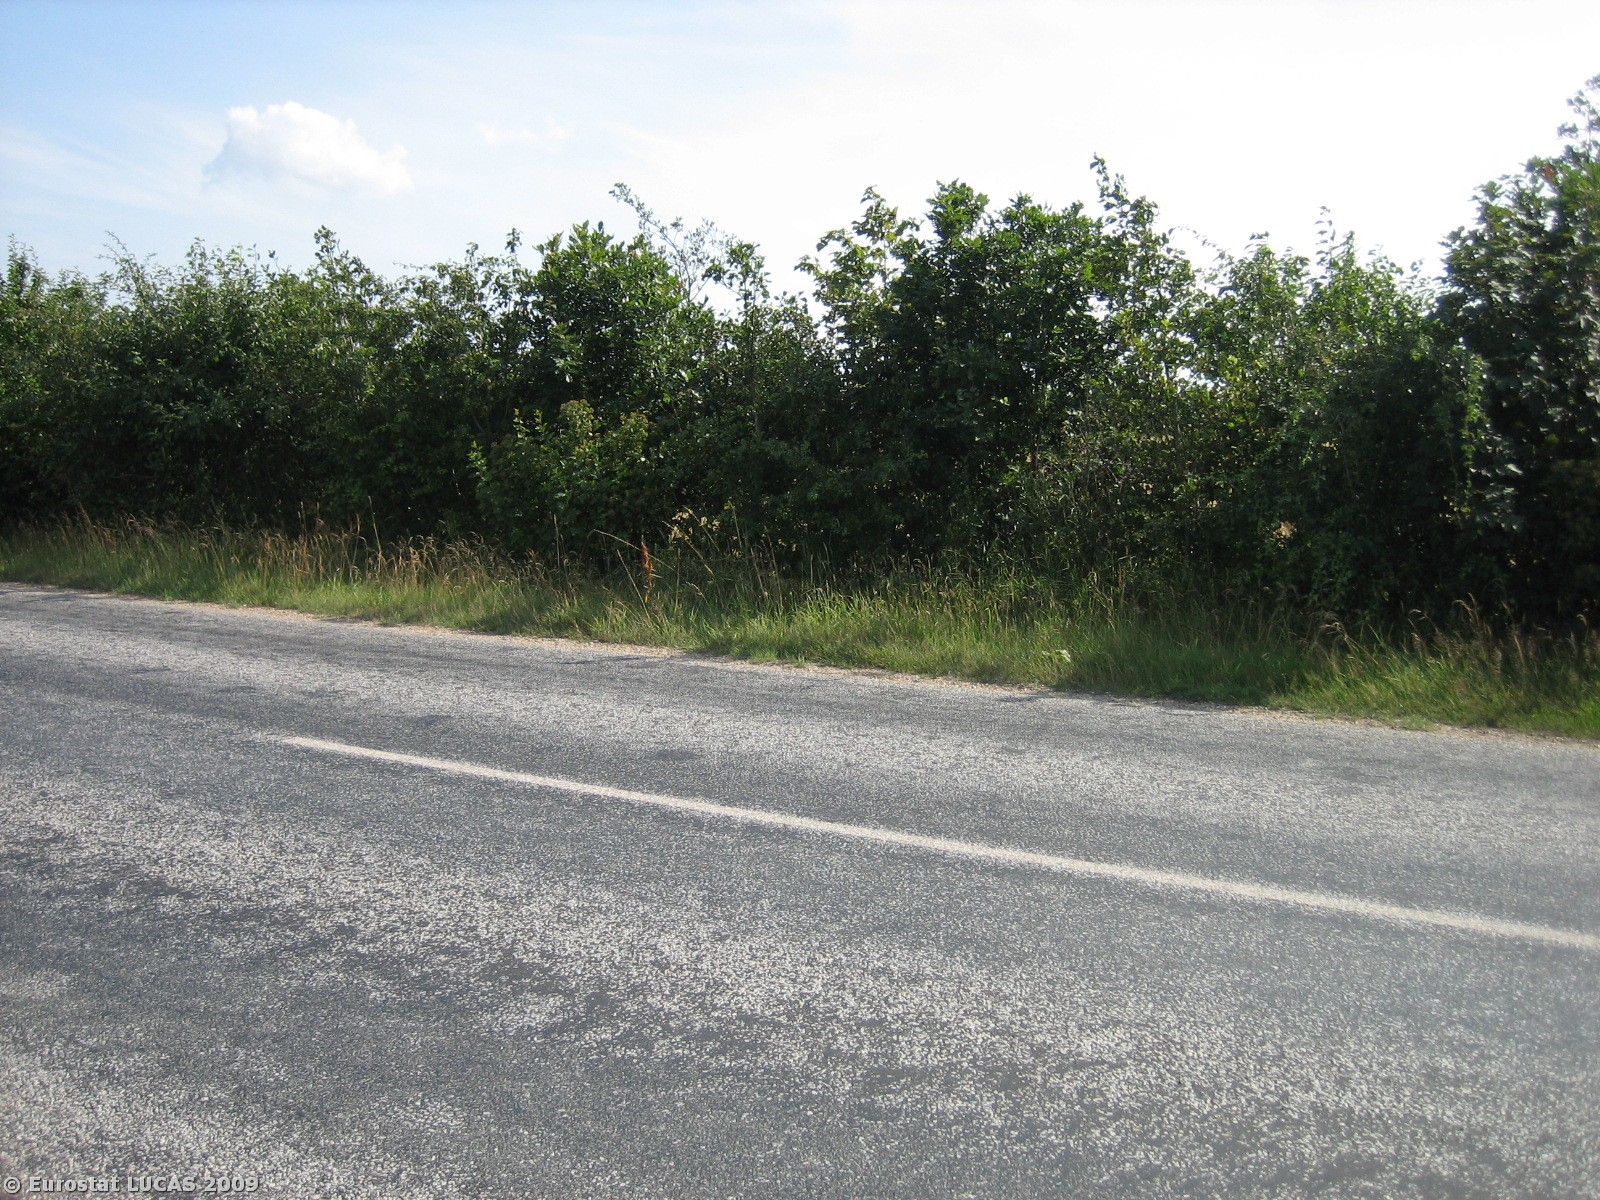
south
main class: Cropland
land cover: Barley
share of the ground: > 75 %
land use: Agriculture (excluding fallow land and kitchen gardens)
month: July
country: DK
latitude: 55.7693
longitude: 8.8694
